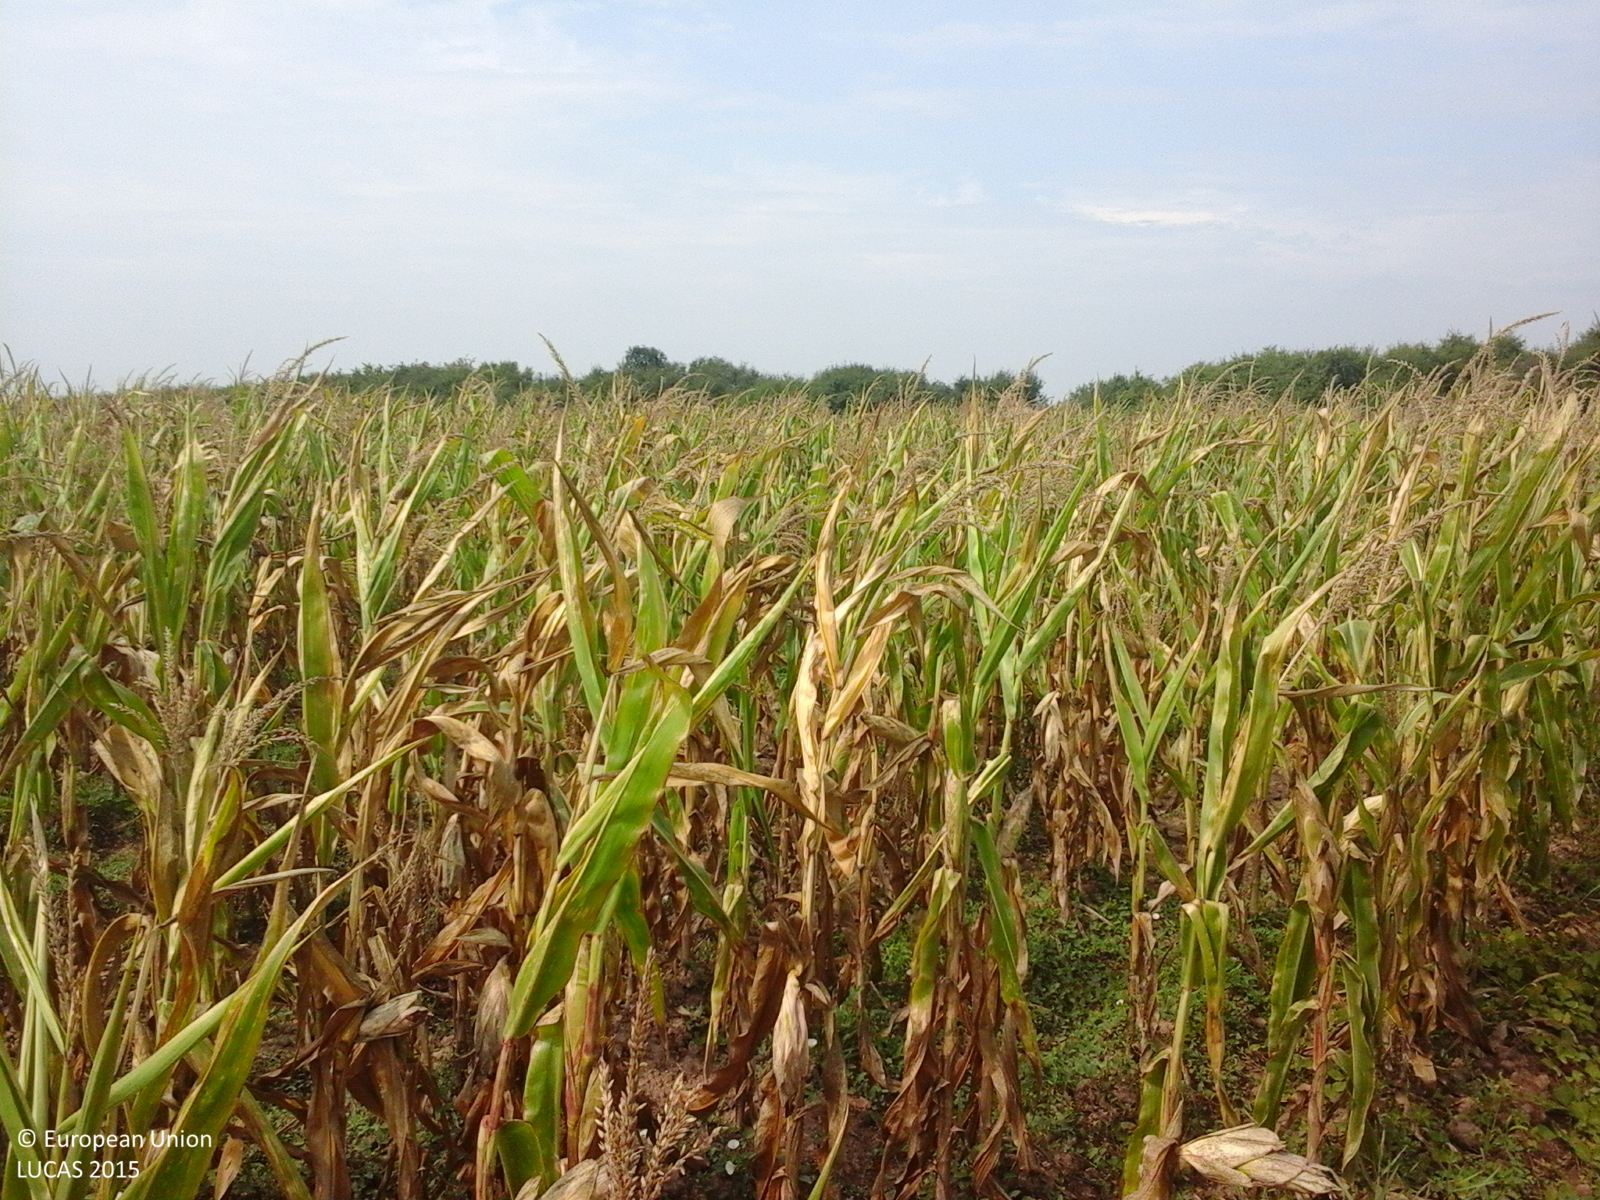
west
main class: Cropland
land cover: Maize
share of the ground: > 75 %
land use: Agriculture (excluding fallow land and kitchen gardens)
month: August
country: RO
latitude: 46.5954
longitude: 21.7236
